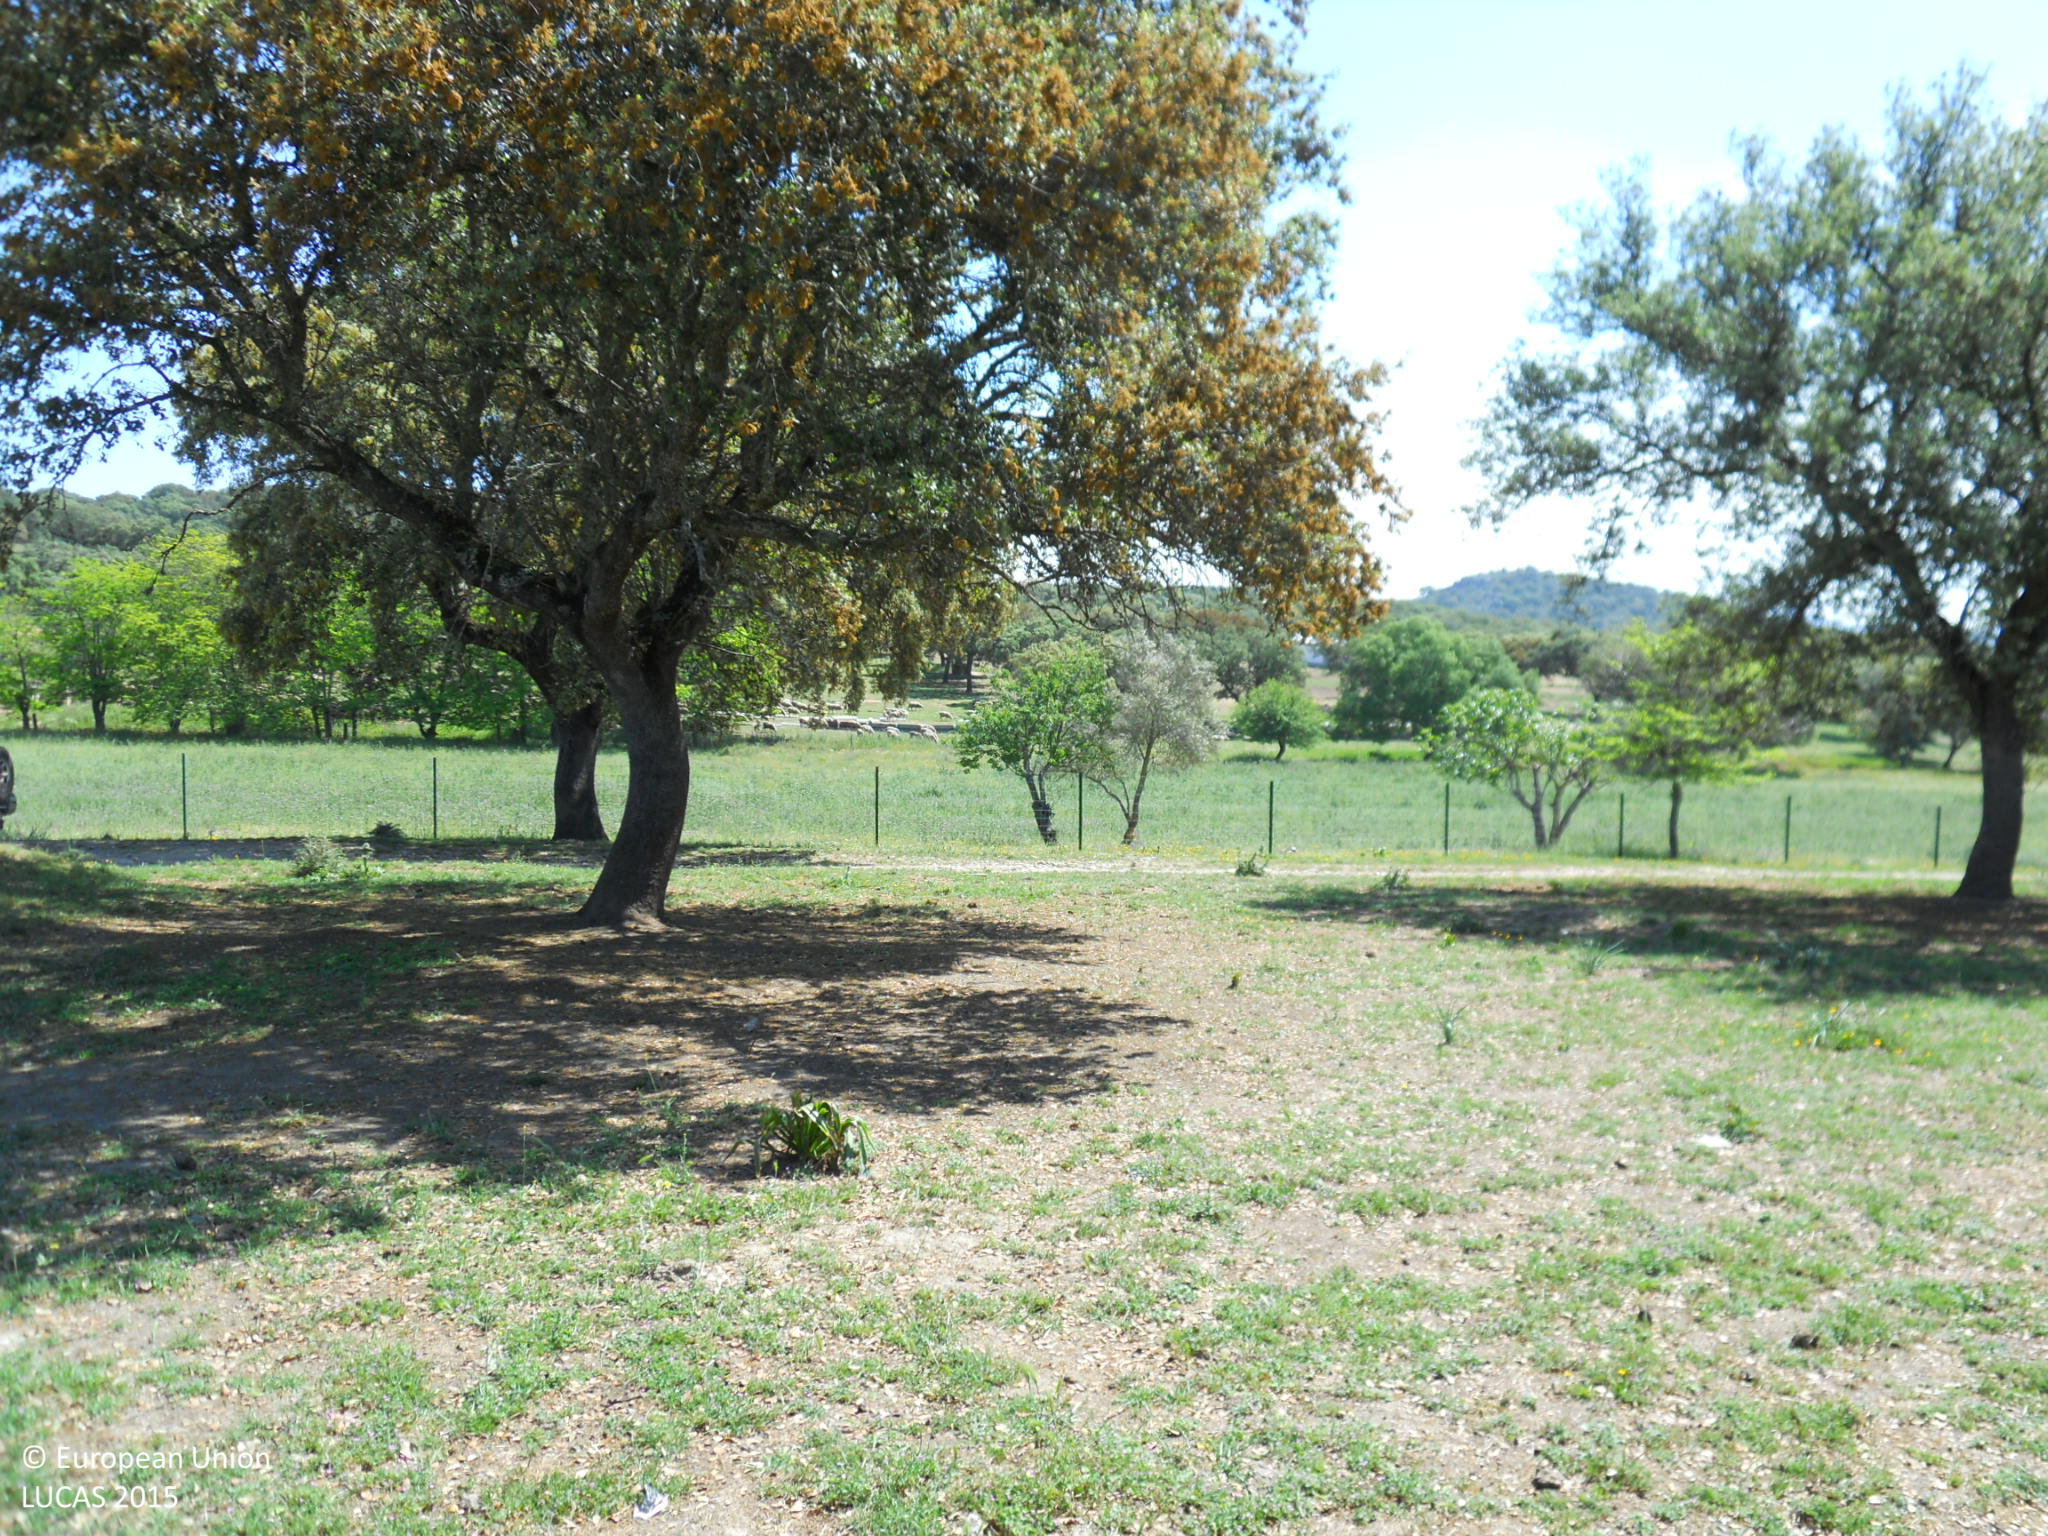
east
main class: Woodland
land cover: Broadleaved woodland
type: broadleaved evergreen forest
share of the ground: > 75 %
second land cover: Grassland without tree/shrub cover
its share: > 75 %
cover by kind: broadleaved forest trees 90 %, herbaceous plants 10 %
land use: Forestry
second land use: Agriculture (excluding fallow land and kitchen gardens)
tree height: > 5 m
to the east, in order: Broadleaved woodland; Grassland without tree/shrub cover; Tracks; Fences; Grassland with sparse tree/shrub cover; Fences; Broadleaved woodland; Grassland with sparse tree/shrub cover; Fences
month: April
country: ES
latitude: 39.2192
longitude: -6.7619
